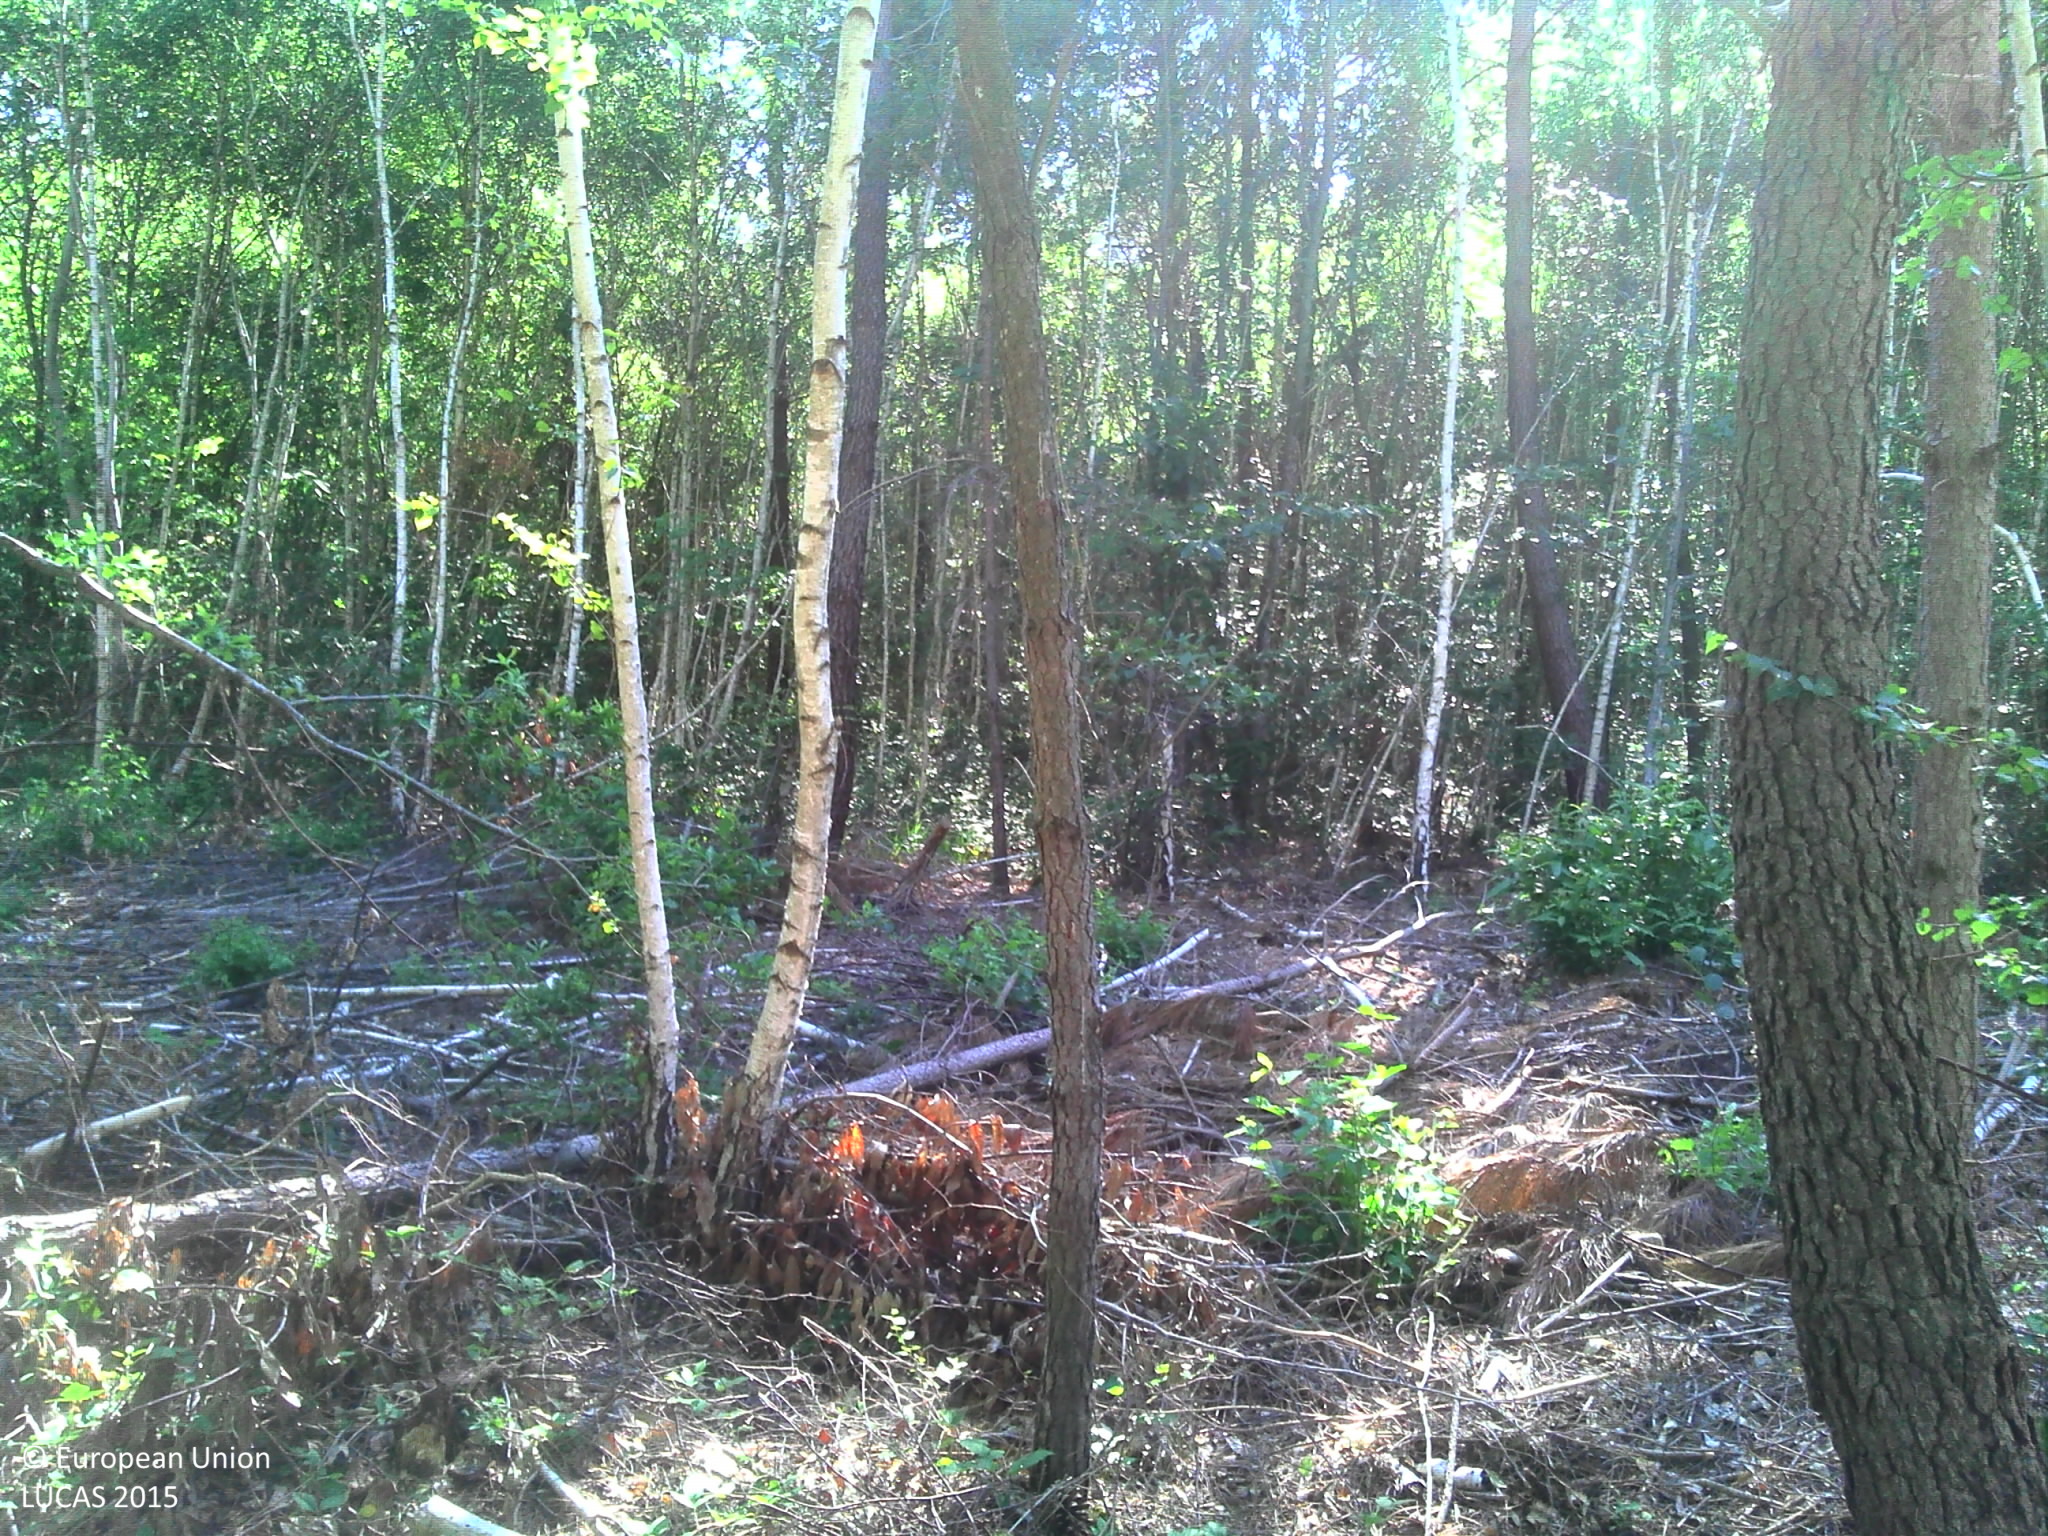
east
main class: Woodland
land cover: Broadleaved woodland
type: mesophytic deciduous forest
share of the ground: > 75 %
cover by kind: broadleaved forest trees 75 %, shrubs 10 %, coniferous forest trees 5 %, herbaceous plants 5 %, lichens and mosses 5 %
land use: Forestry
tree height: > 5 m
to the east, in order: Broadleaved woodland; Ditches and canals; Broadleaved woodland; Tracks
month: June
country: FR
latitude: 47.4001
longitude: 0.3447
